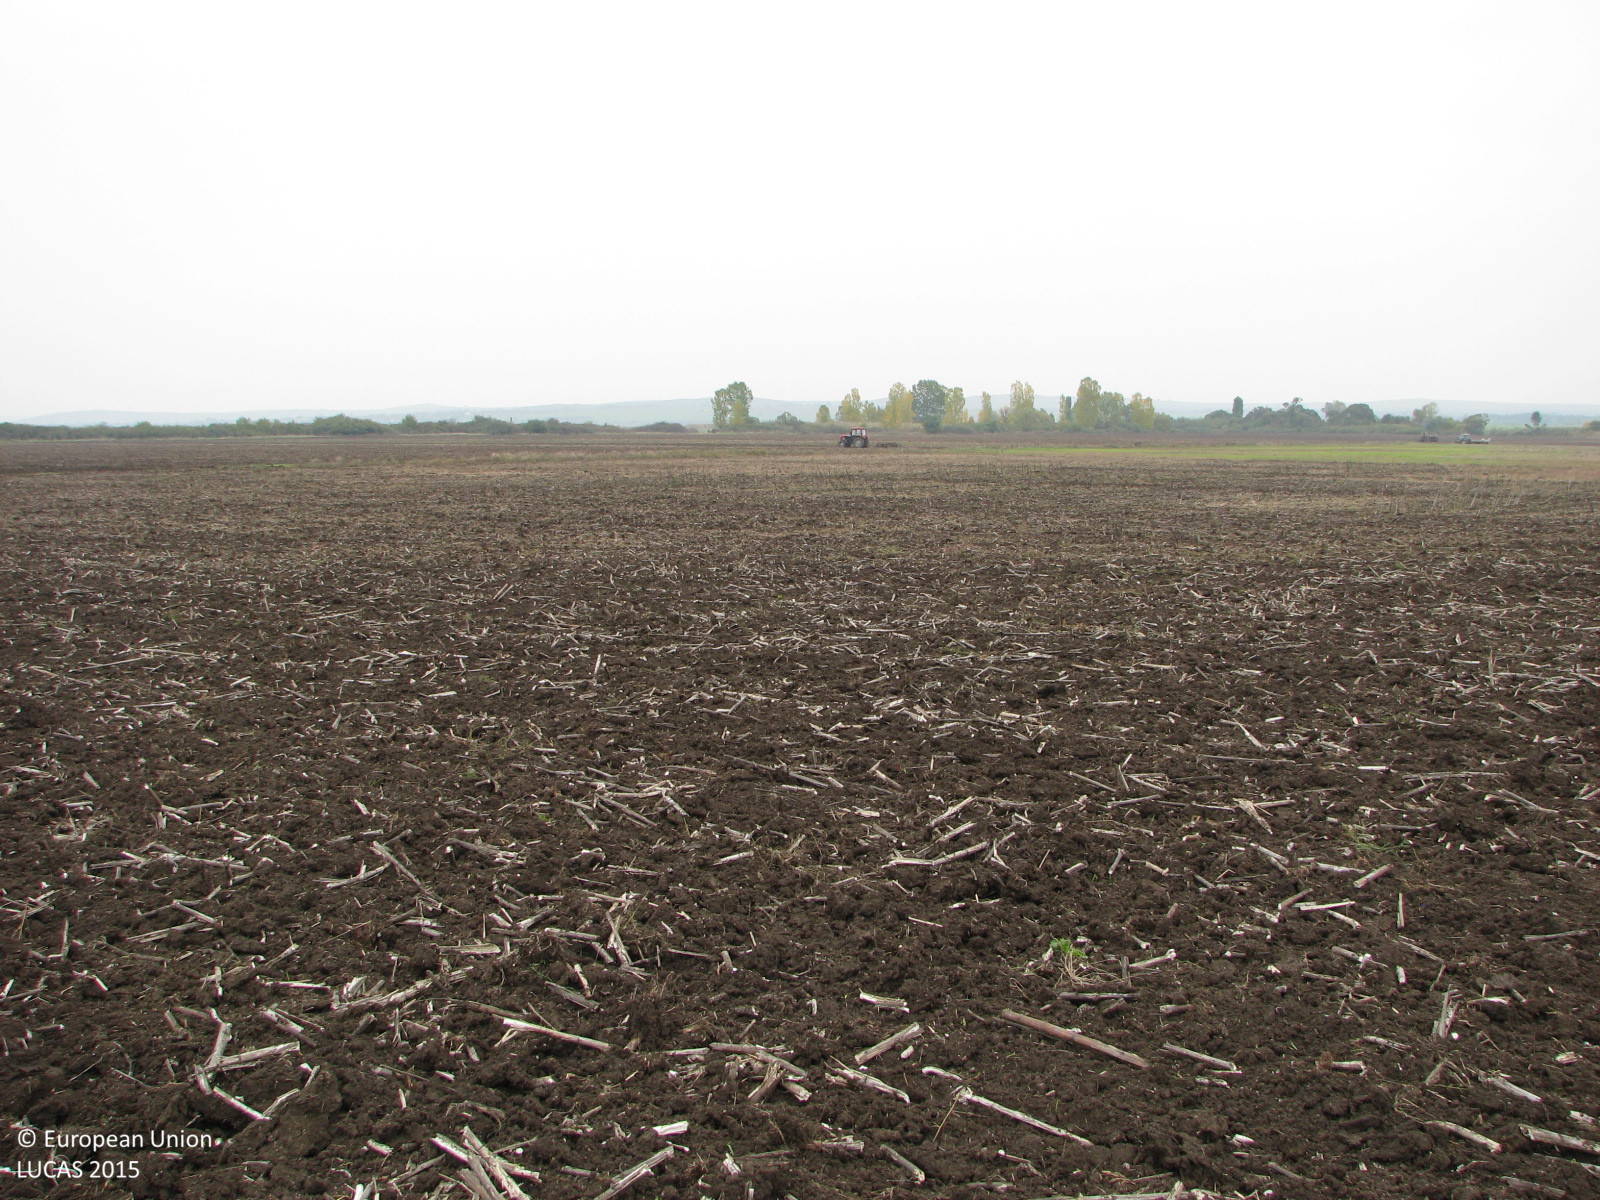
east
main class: Cropland
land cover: Rape and turnip rape
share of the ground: < 10 %
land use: Agriculture (excluding fallow land and kitchen gardens)
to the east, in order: Rape and turnip rape; Common wheat
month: October
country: BG
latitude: 42.5465
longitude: 26.7955
